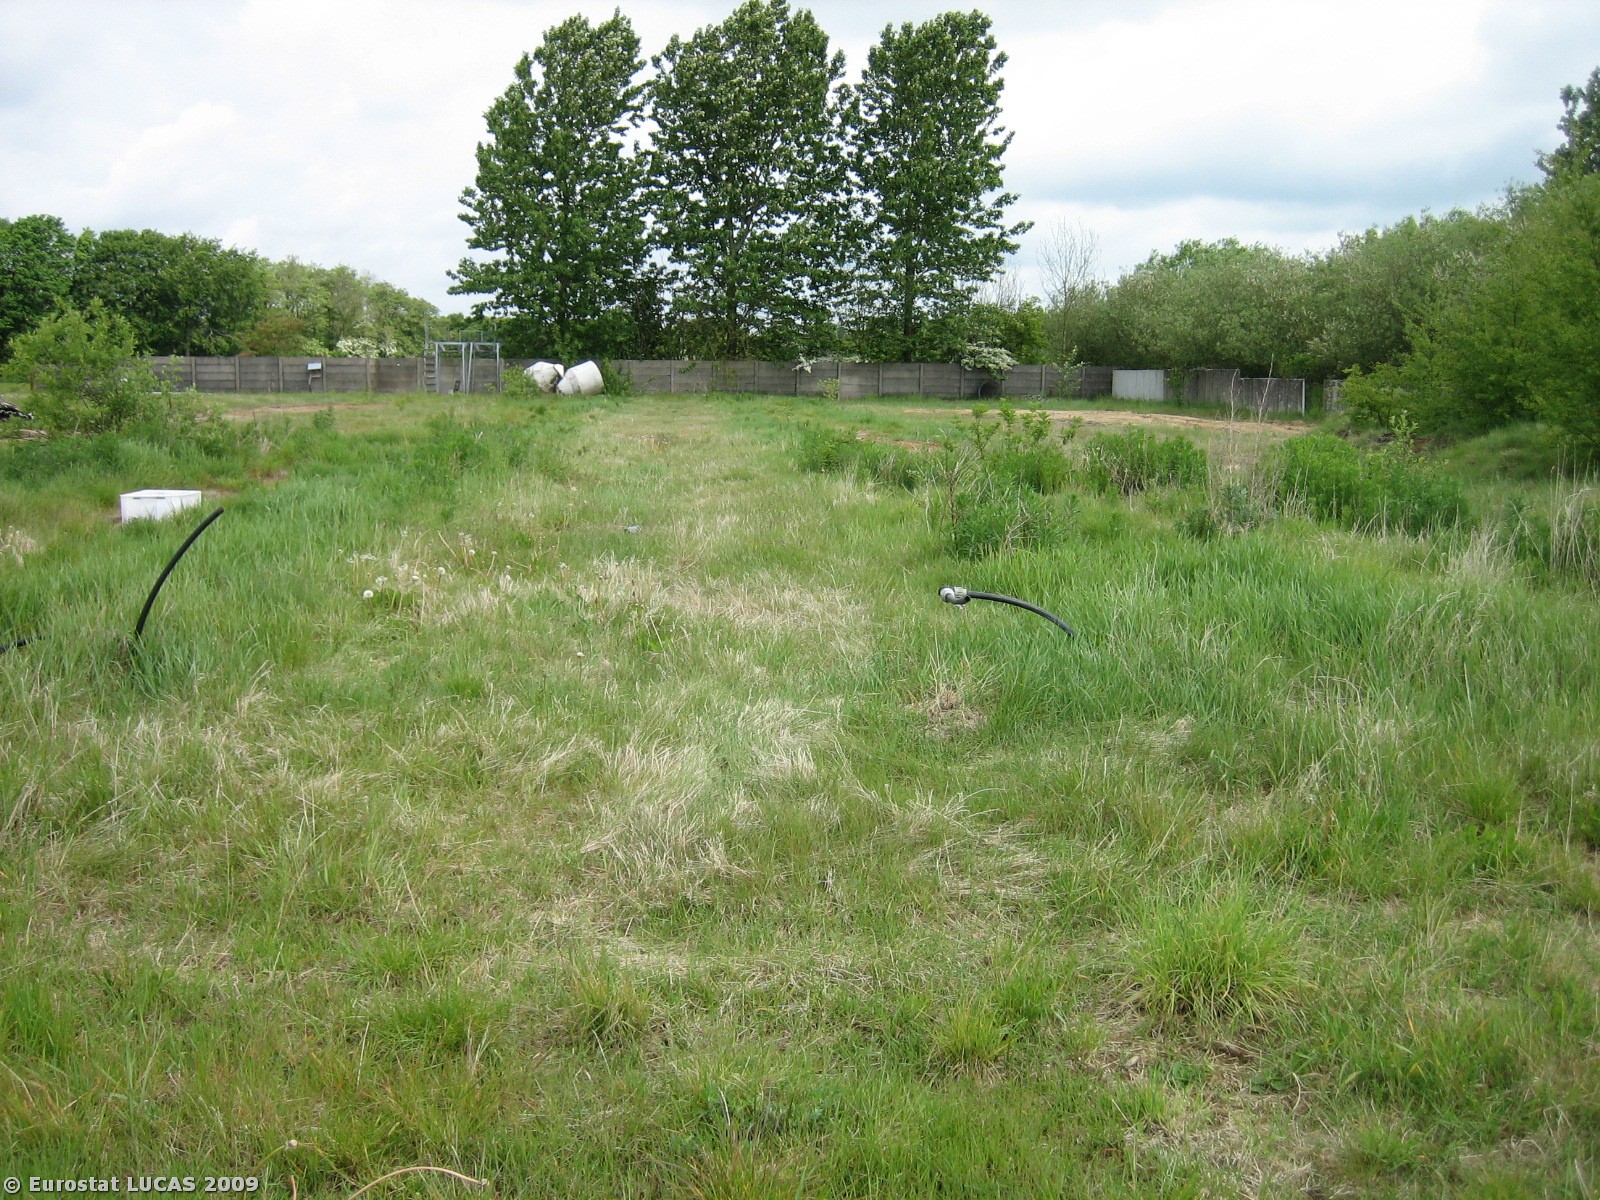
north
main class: Grassland
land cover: Grassland with sparse tree/shrub cover
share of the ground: > 75 %
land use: Logistics and storage
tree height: > 5 m
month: May
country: DK
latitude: 56.0922
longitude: 8.7959
